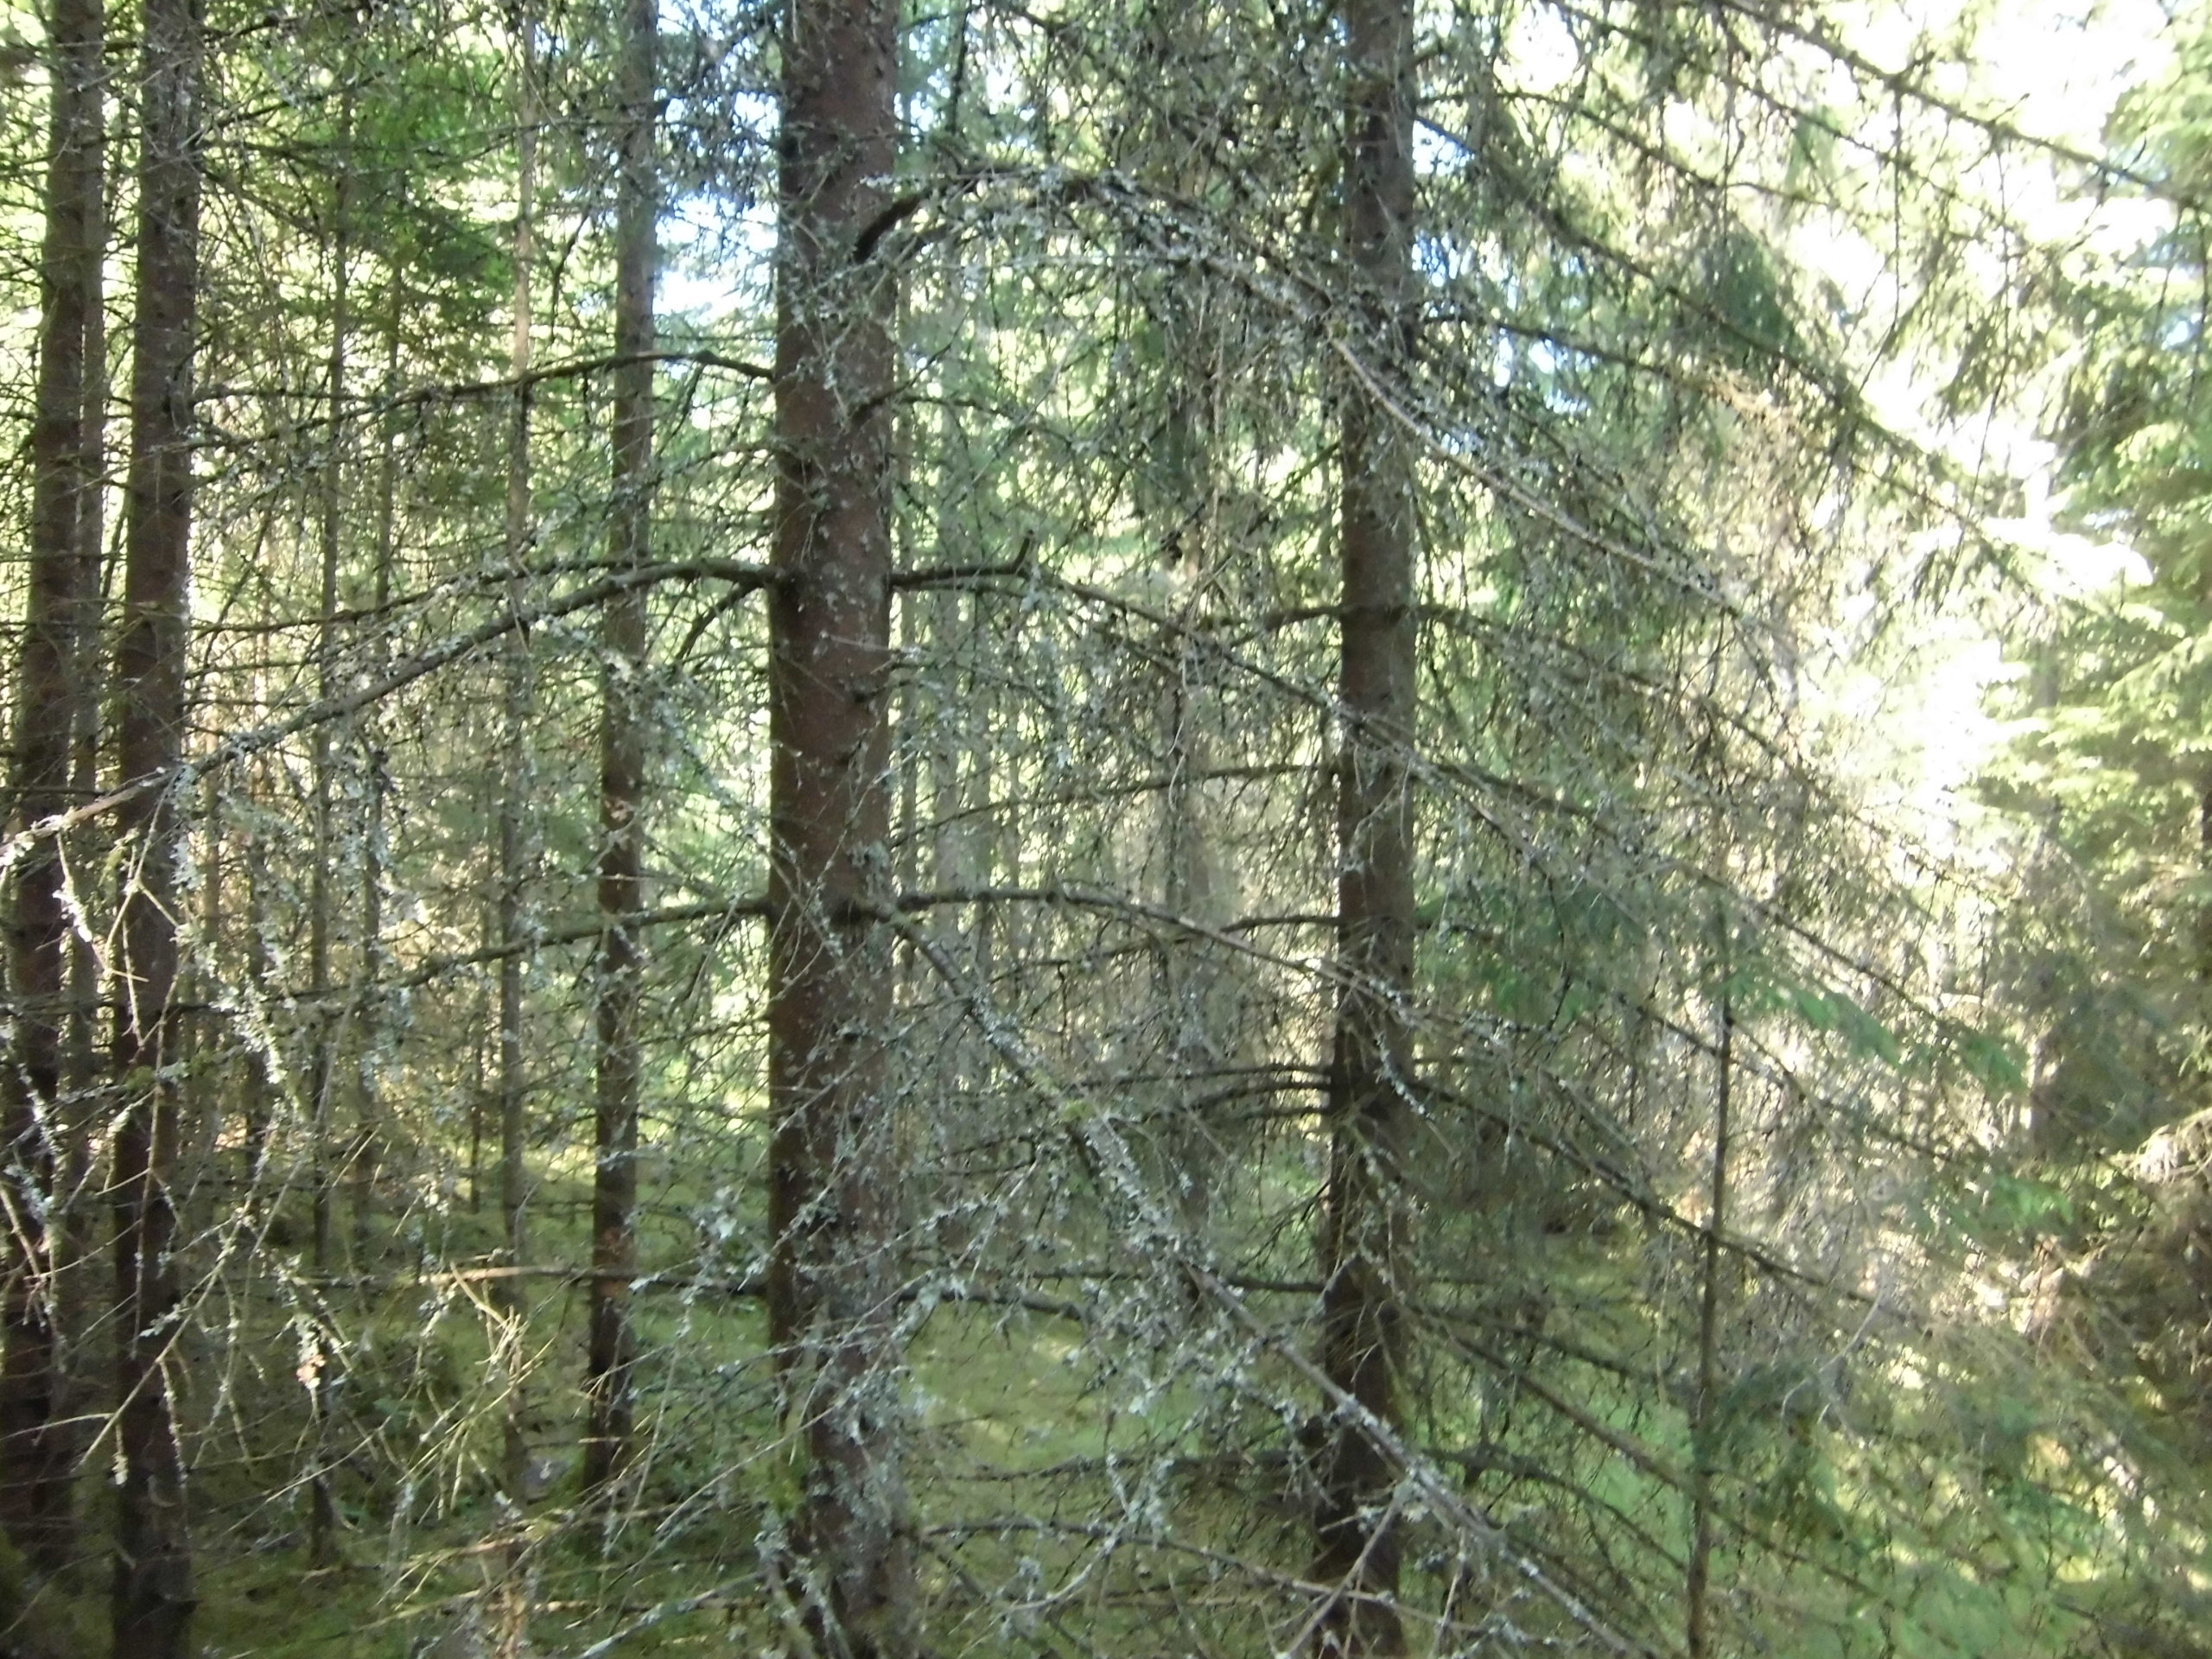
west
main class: Woodland
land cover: Spruce dominated coniferous woodland
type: boreal forest
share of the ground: 50 - 75 %
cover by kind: coniferous forest trees 50 %, shrubs 15 %, lichens and mosses 15 %, broadleaved forest trees 10 %, herbaceous plants 10 %
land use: Forestry
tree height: > 5 m
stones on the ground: > 50 %
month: July
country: SE
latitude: 57.1976
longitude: 14.7796
